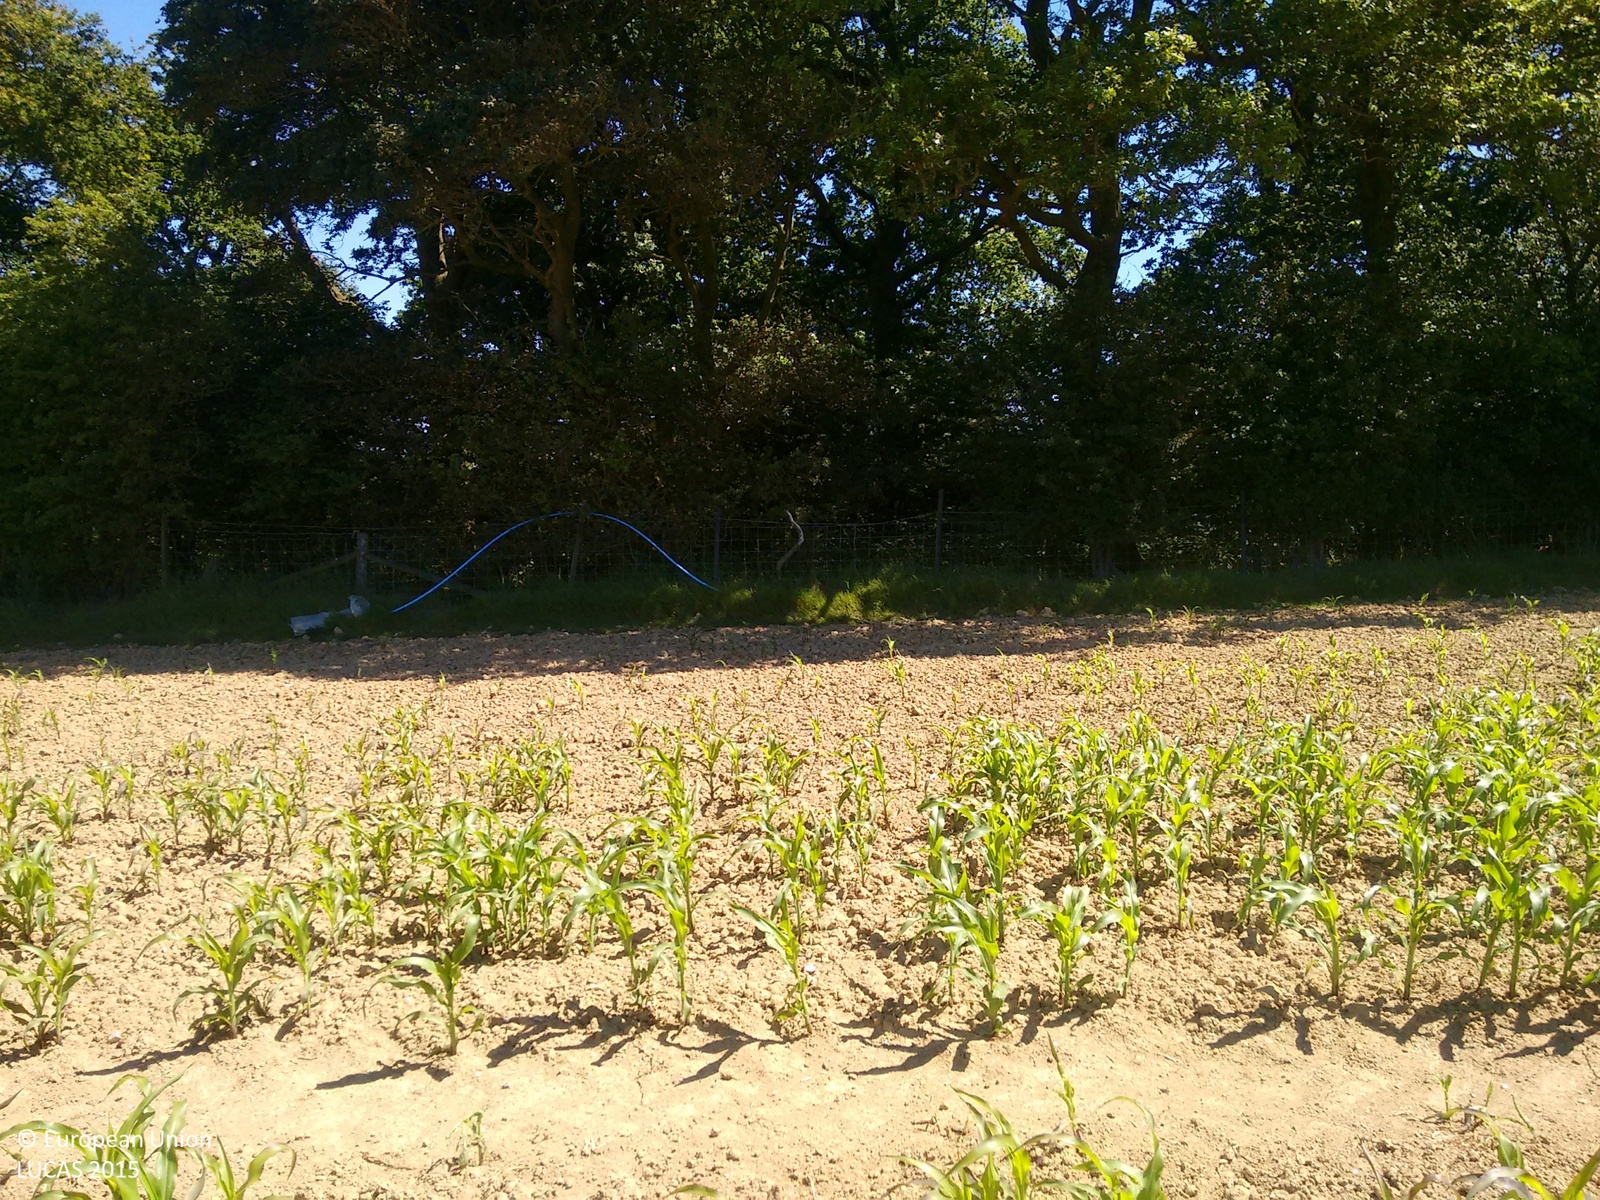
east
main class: Cropland
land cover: Maize
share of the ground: > 75 %
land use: Agriculture (excluding fallow land and kitchen gardens)
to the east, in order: Maize; Fences; Broadleaved woodland; Fences; Tracks; Temporary grasslands; Fences; Grass margins; Fences; Grassland without tree/shrub cover
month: June
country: GB
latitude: 50.9113
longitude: -0.3191
